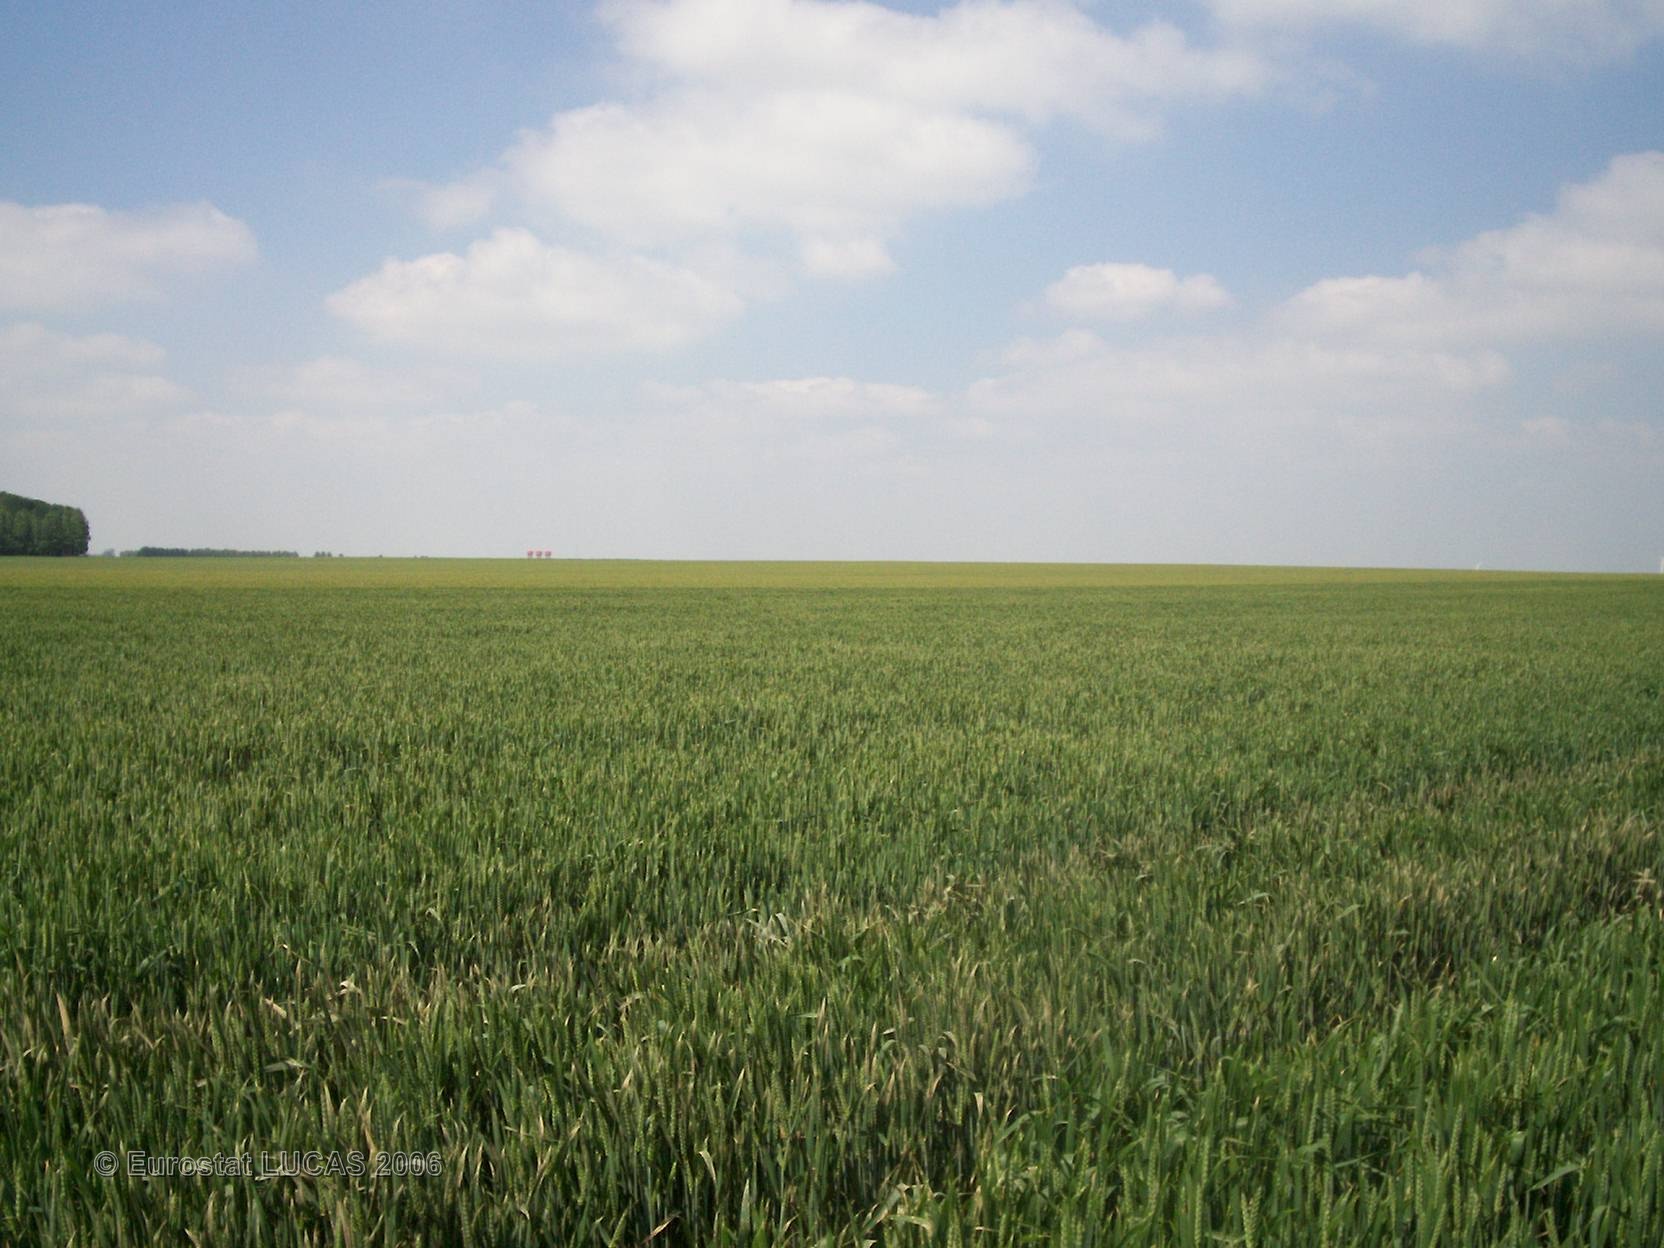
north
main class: Cropland
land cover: Common wheat
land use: Agriculture (excluding fallow land and kitchen gardens)
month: June
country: FR
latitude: 49.7856
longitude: 2.6690
